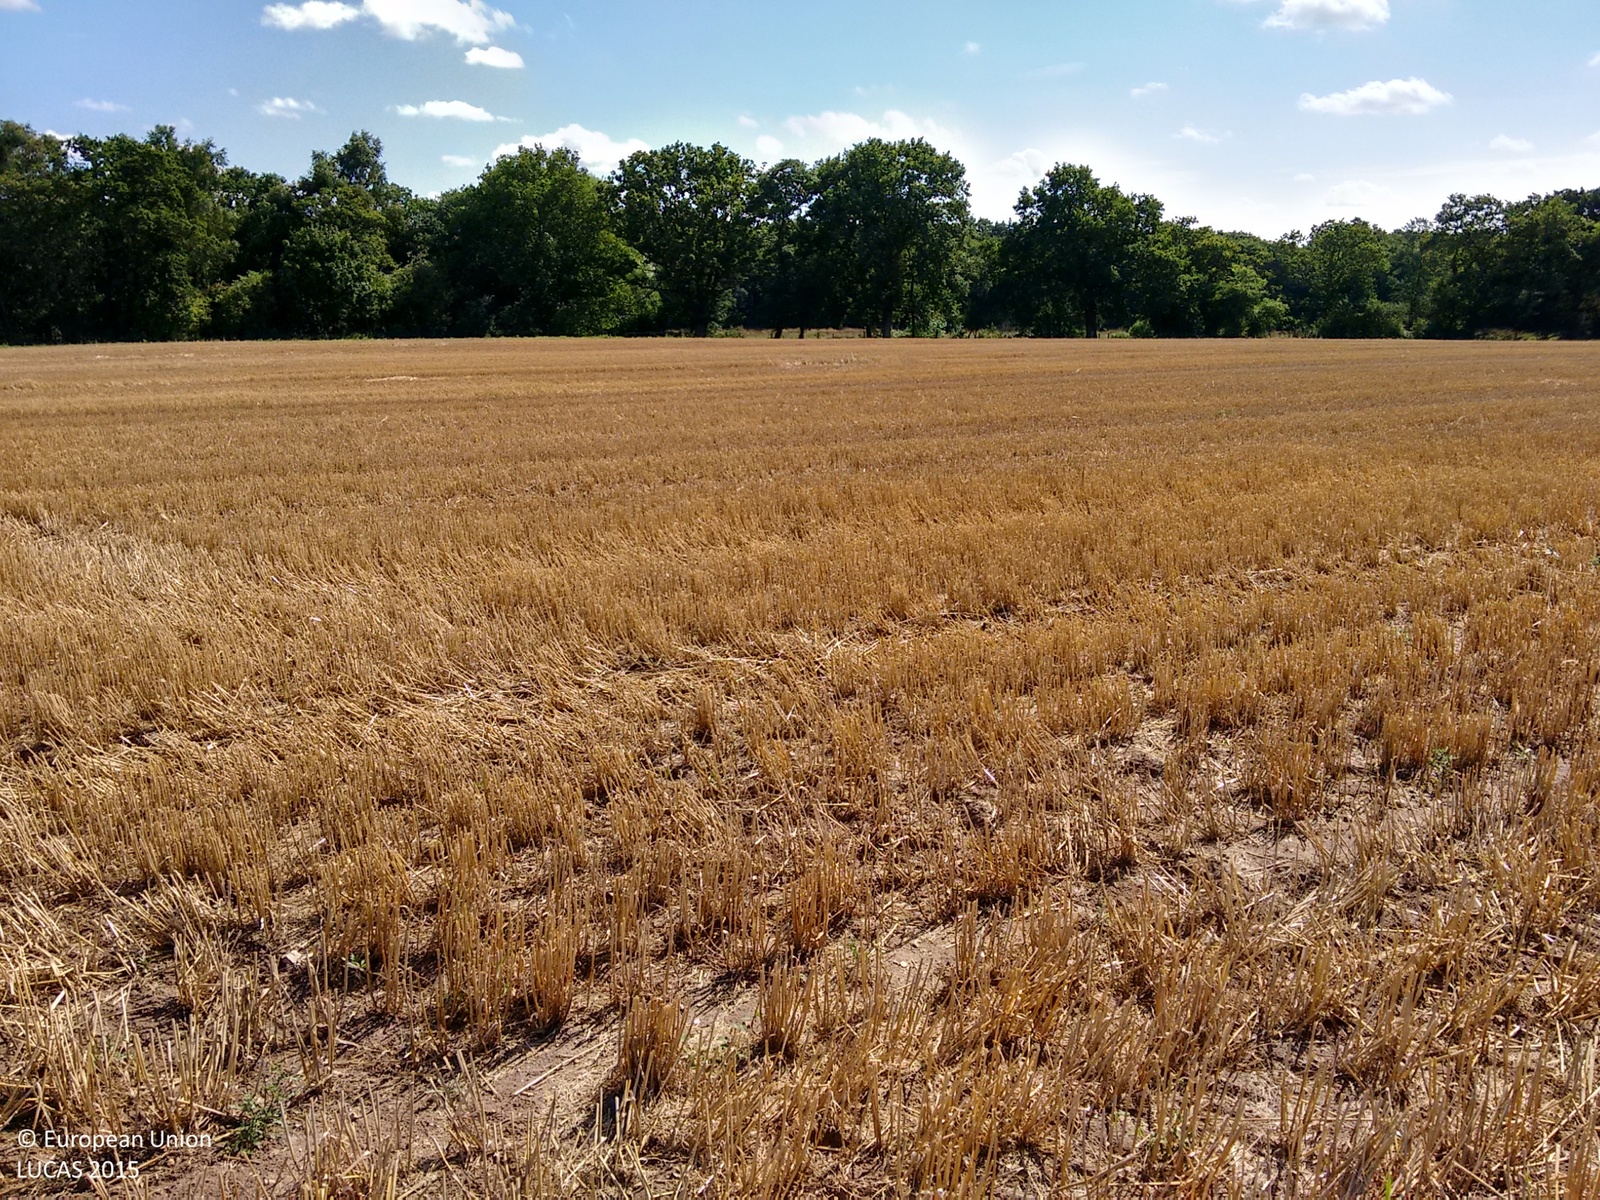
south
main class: Cropland
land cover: Common wheat
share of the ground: > 75 %
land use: Agriculture (excluding fallow land and kitchen gardens)
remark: Harvested field
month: August
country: GB
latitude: 52.7261
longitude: 0.8099
